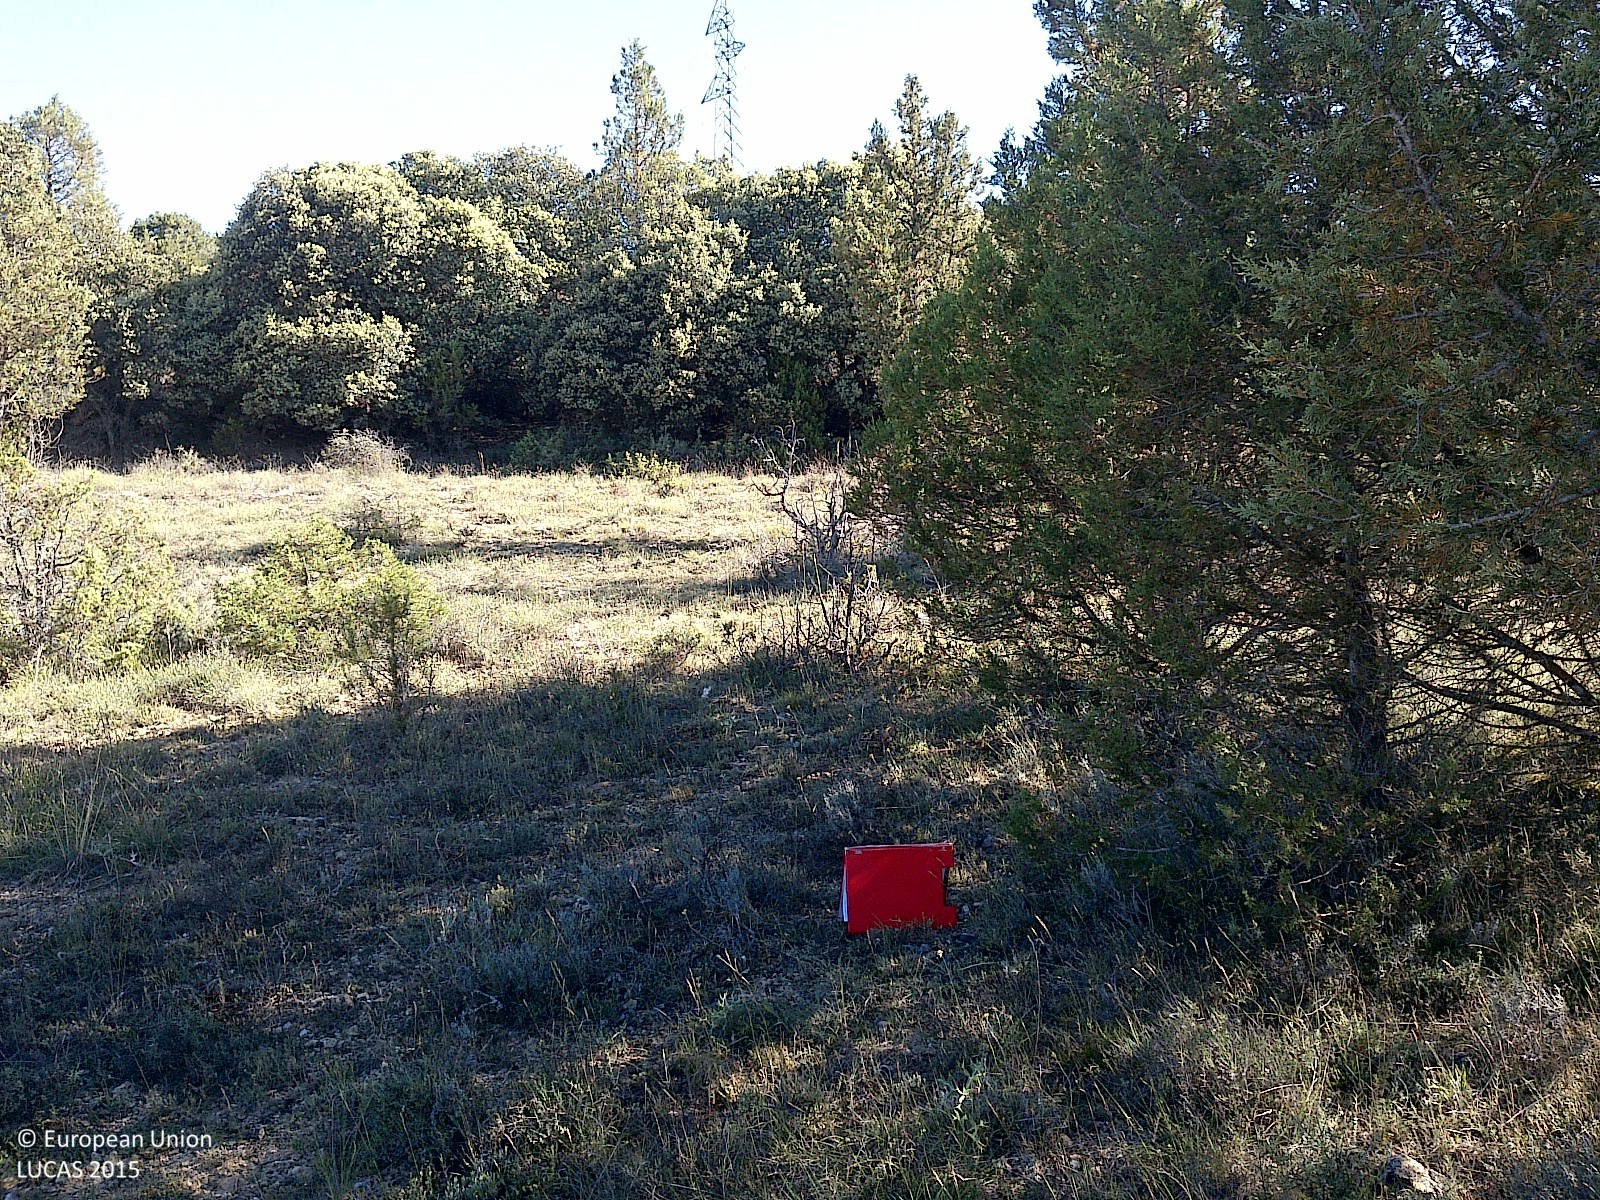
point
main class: Woodland
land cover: Other coniferous woodland
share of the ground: 10 - 25 %
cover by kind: herbaceous plants 65 %, coniferous forest trees 15 %, shrubs 15 %, unconsolidated bare surface 5 %
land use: Semi-natural and natural areas not in use
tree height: < 5 m
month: July
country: ES
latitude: 41.6935
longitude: -2.7893
